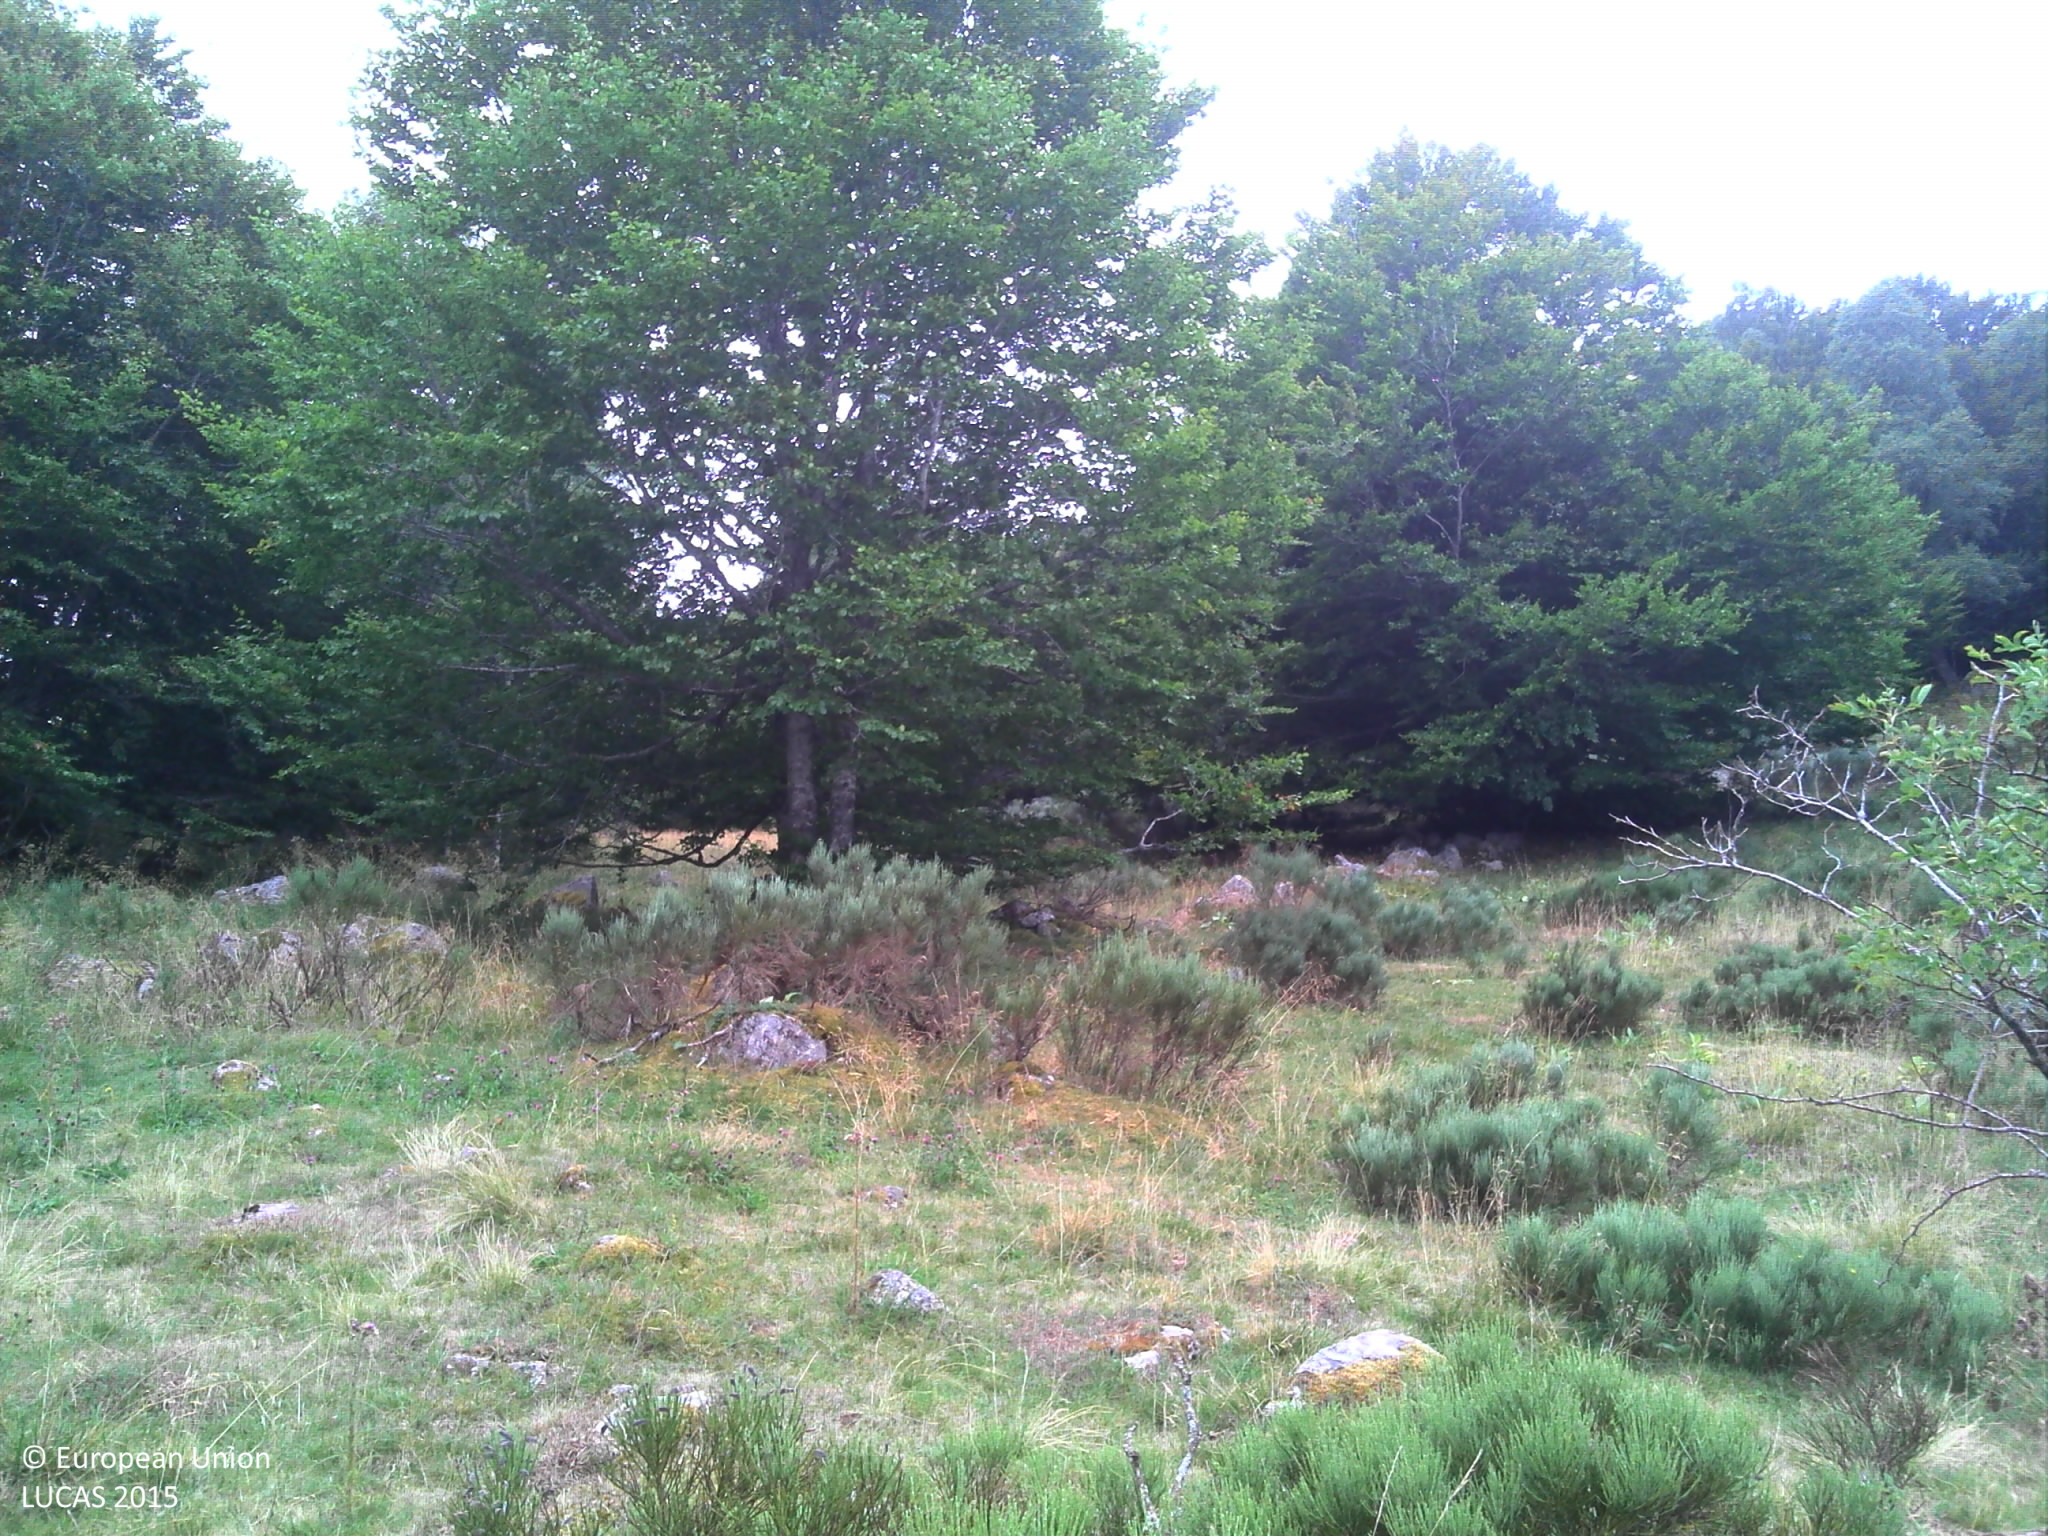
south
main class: Shrubland
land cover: Shrubland with sparse tree cover
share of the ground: > 75 %
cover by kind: shrubs 60 %, herbaceous plants 35 %, coniferous forest trees 5 %
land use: Agriculture (excluding fallow land and kitchen gardens)
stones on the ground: 25 - 50 %
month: July
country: FR
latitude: 44.6538
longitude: 3.5105
